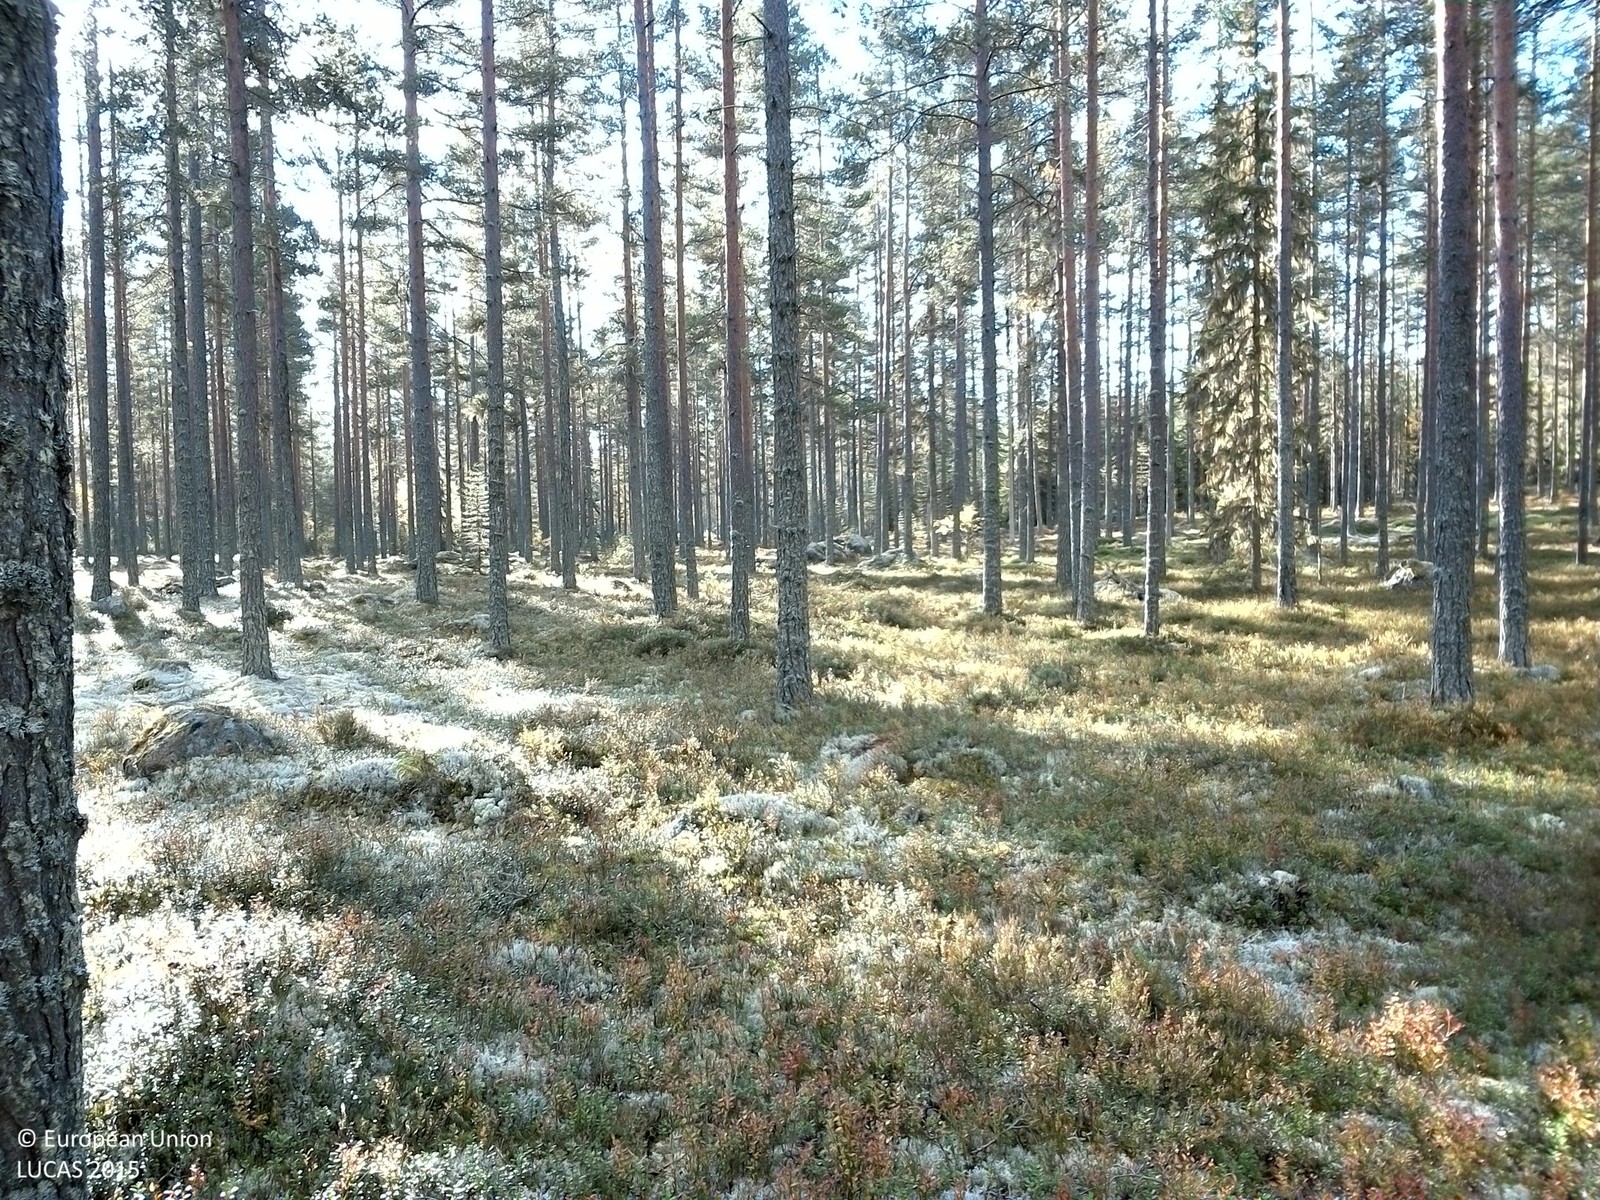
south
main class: Woodland
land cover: Pine dominated coniferous woodland
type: boreal forest
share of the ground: 50 - 75 %
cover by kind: coniferous forest trees 60 %, shrubs 30 %, lichens and mosses 5 %, consolidated bare surface 5 %
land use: Forestry
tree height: > 5 m
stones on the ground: 10 - 25 %
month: October
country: SE
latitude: 61.2253
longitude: 15.1065
